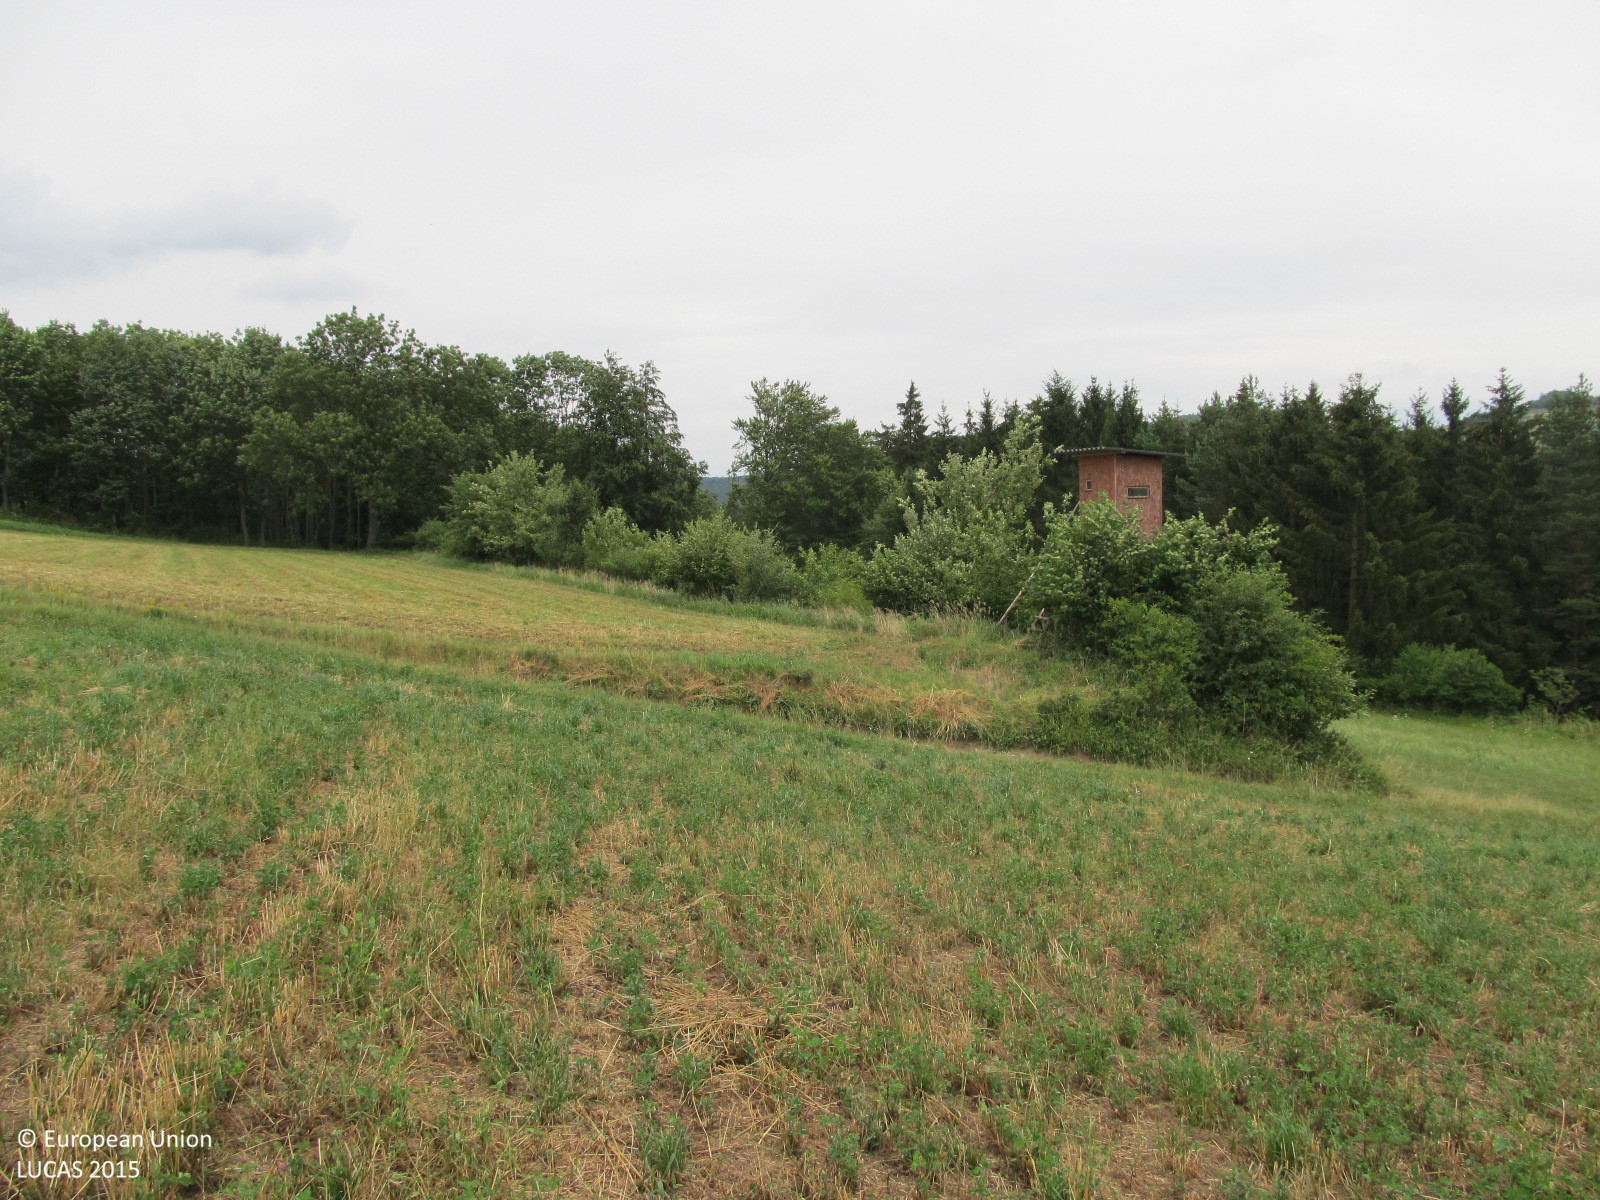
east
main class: Cropland
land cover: Temporary grasslands
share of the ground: > 75 %
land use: Agriculture (excluding fallow land and kitchen gardens)
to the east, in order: Temporary grasslands; Tracks; Temporary grasslands; Grass margins; Shrubland with sparse tree cover; Grassland without tree/shrub cover; Broadleaved woodland; Ditches and canals; Spruce dominated coniferous woodland; Shrubland with sparse tree cover
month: July
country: AT
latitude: 48.4494
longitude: 15.4512
